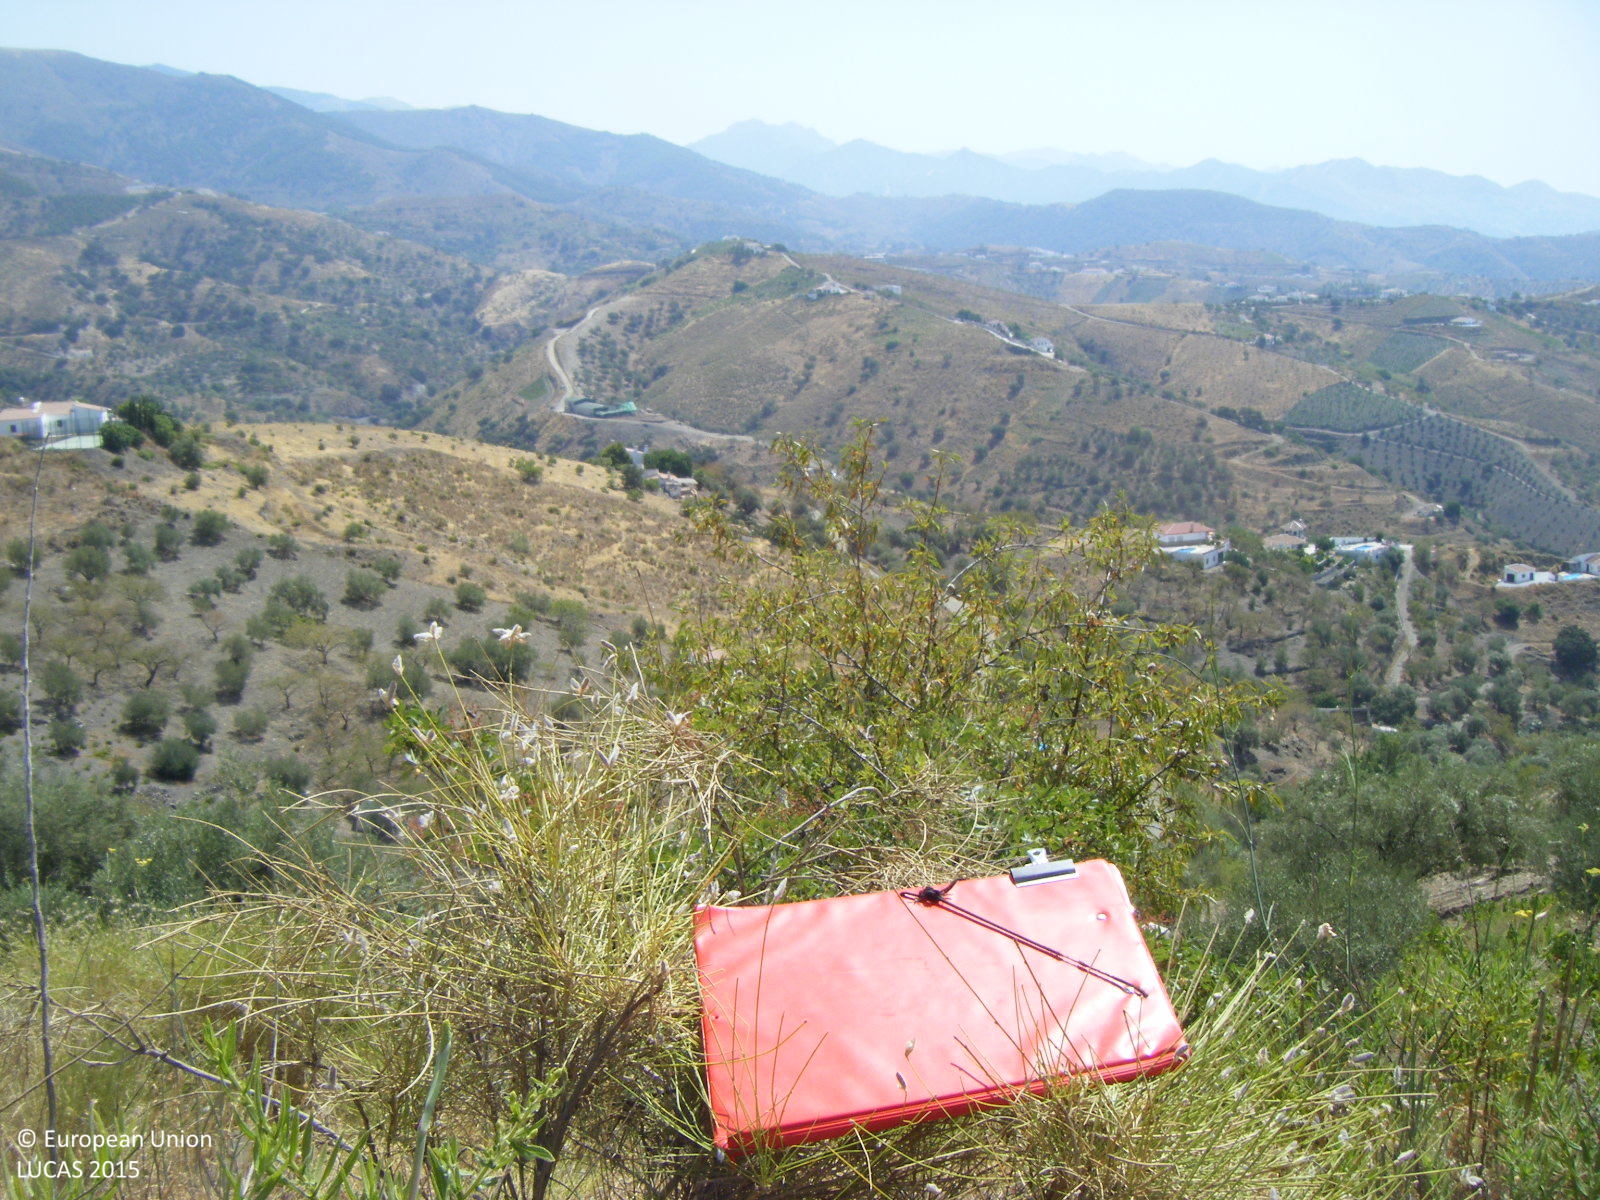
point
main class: Shrubland
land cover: Shrubland without tree cover
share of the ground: 50 - 75 %
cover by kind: shrubs 60 %, herbaceous plants 40 %
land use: Semi-natural and natural areas not in use
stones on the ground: 10 - 25 %
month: July
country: ES
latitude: 36.8619
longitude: -4.0656
